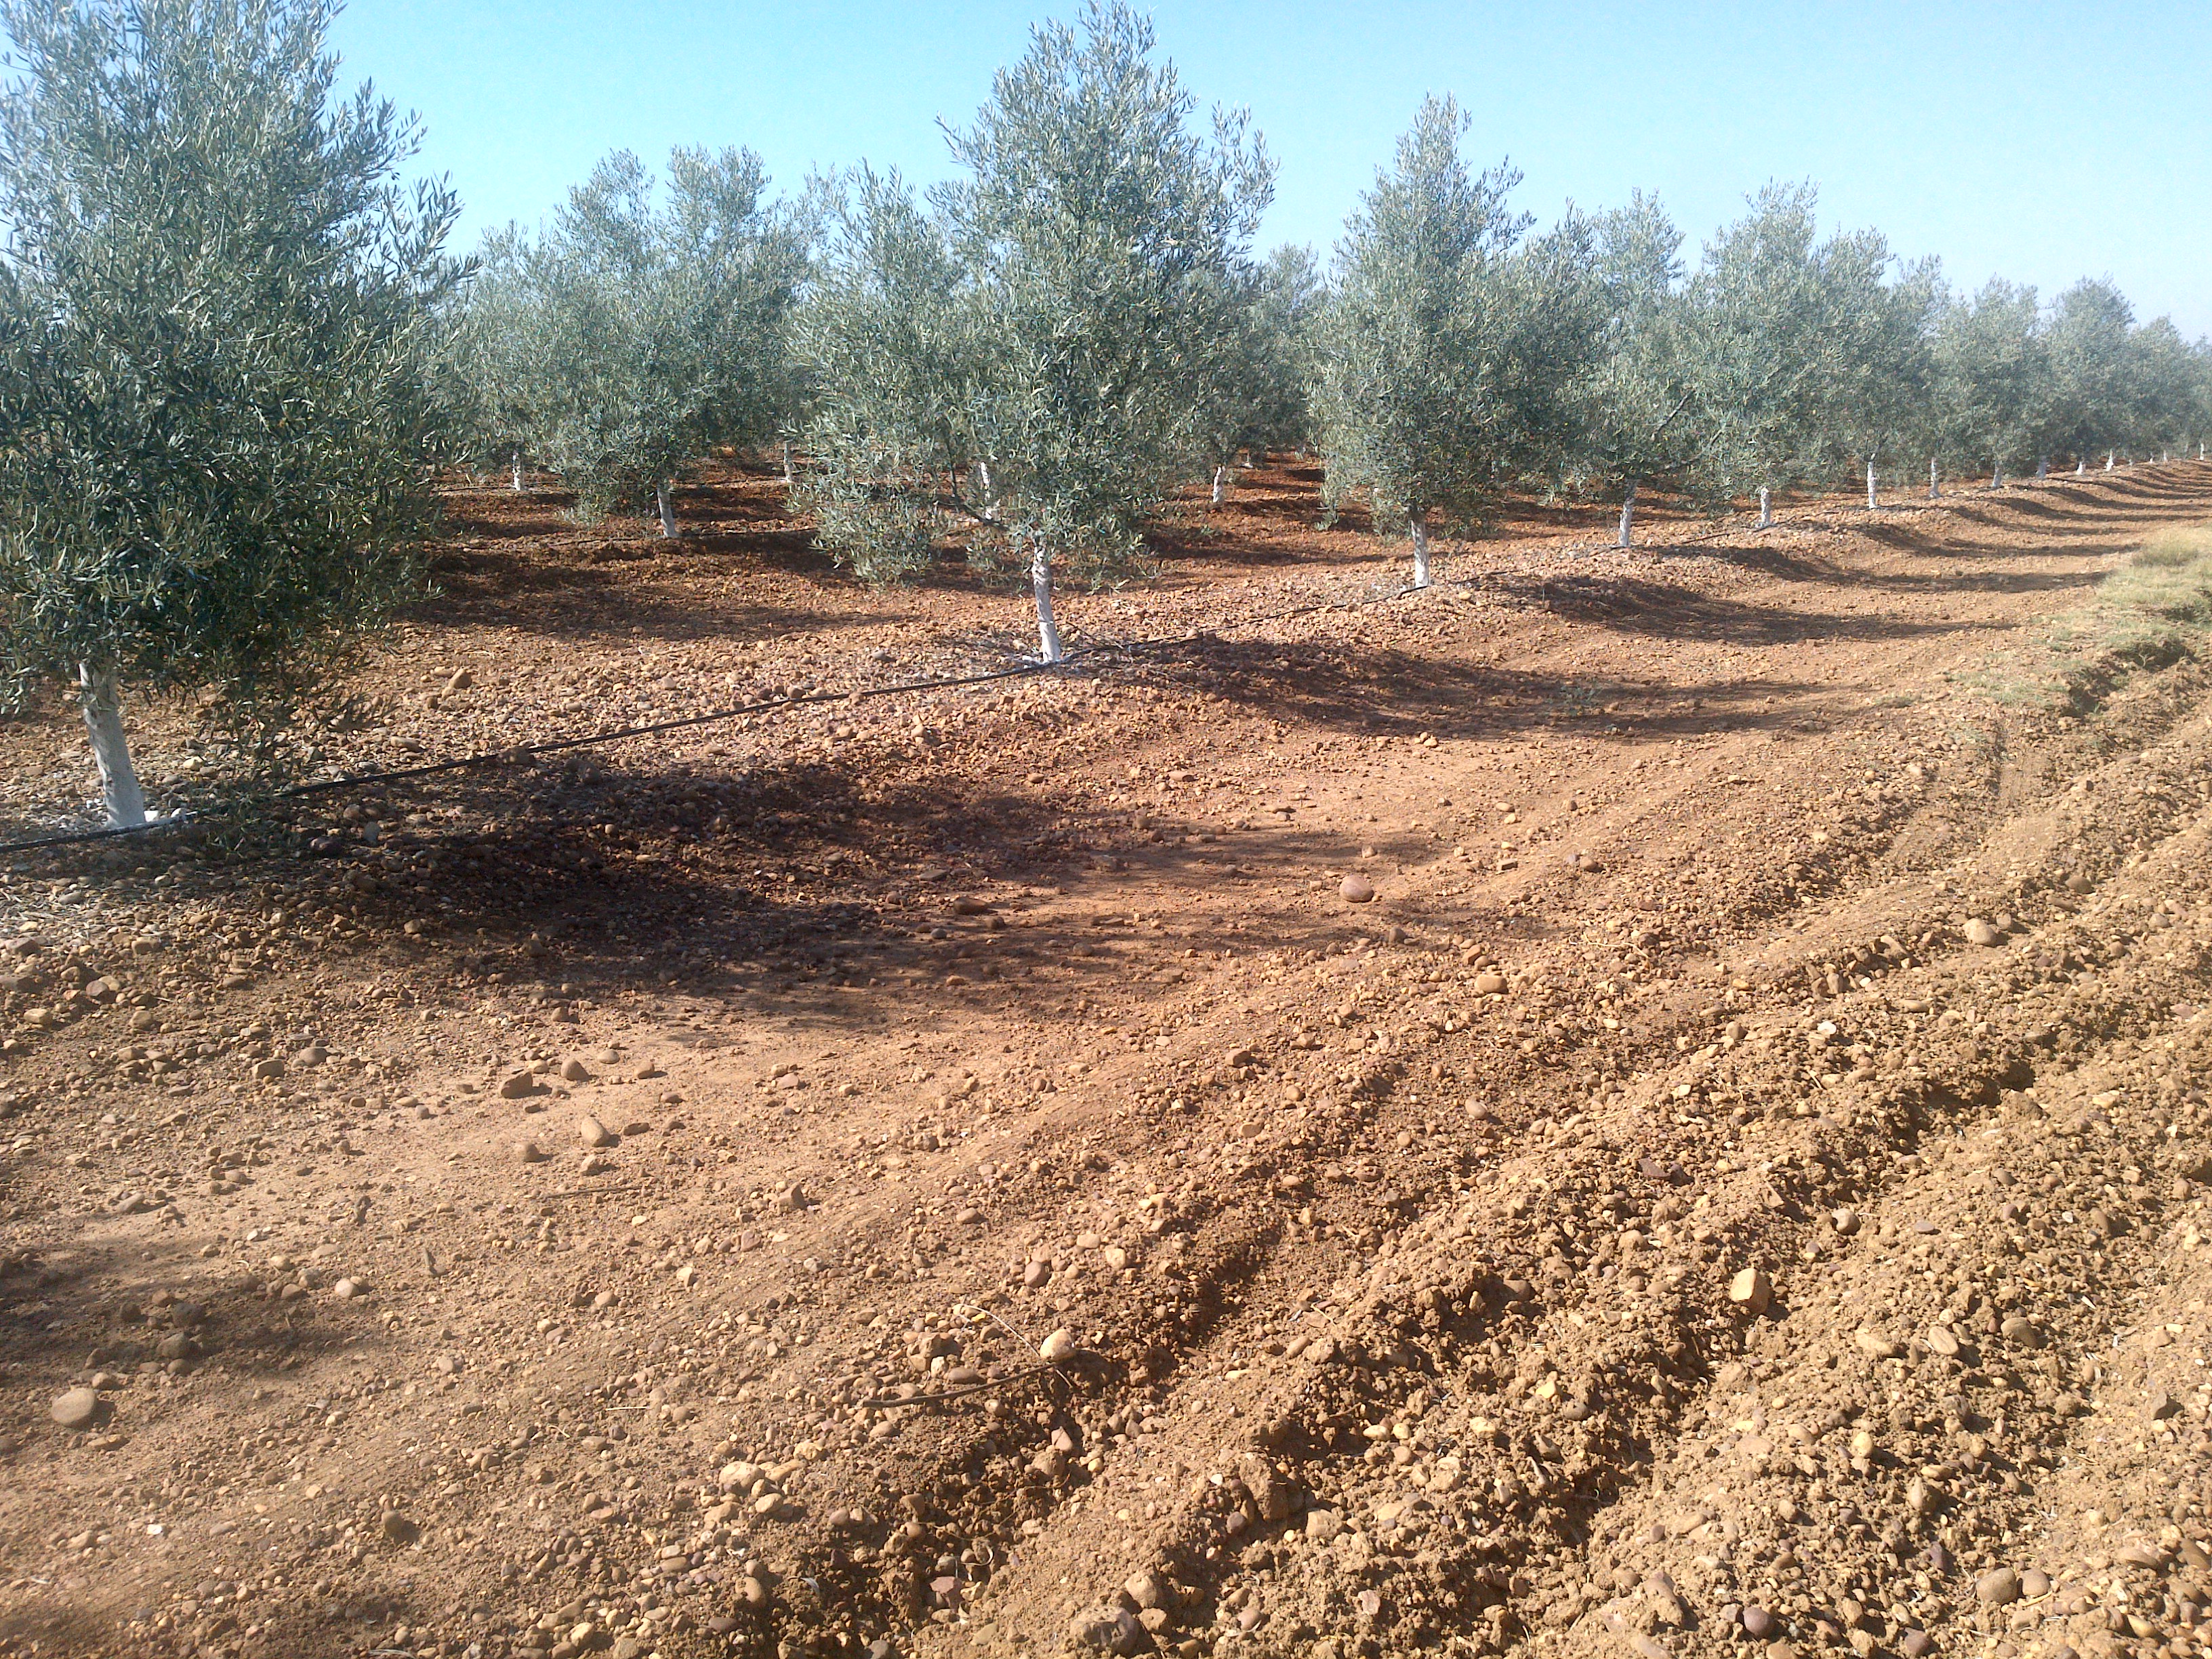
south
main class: Cropland
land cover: Olive groves
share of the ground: 25 - 50 %
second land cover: Other bare soil
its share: > 75 %
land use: Agriculture (excluding fallow land and kitchen gardens)
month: June
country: ES
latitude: 37.7170
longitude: -4.9546
